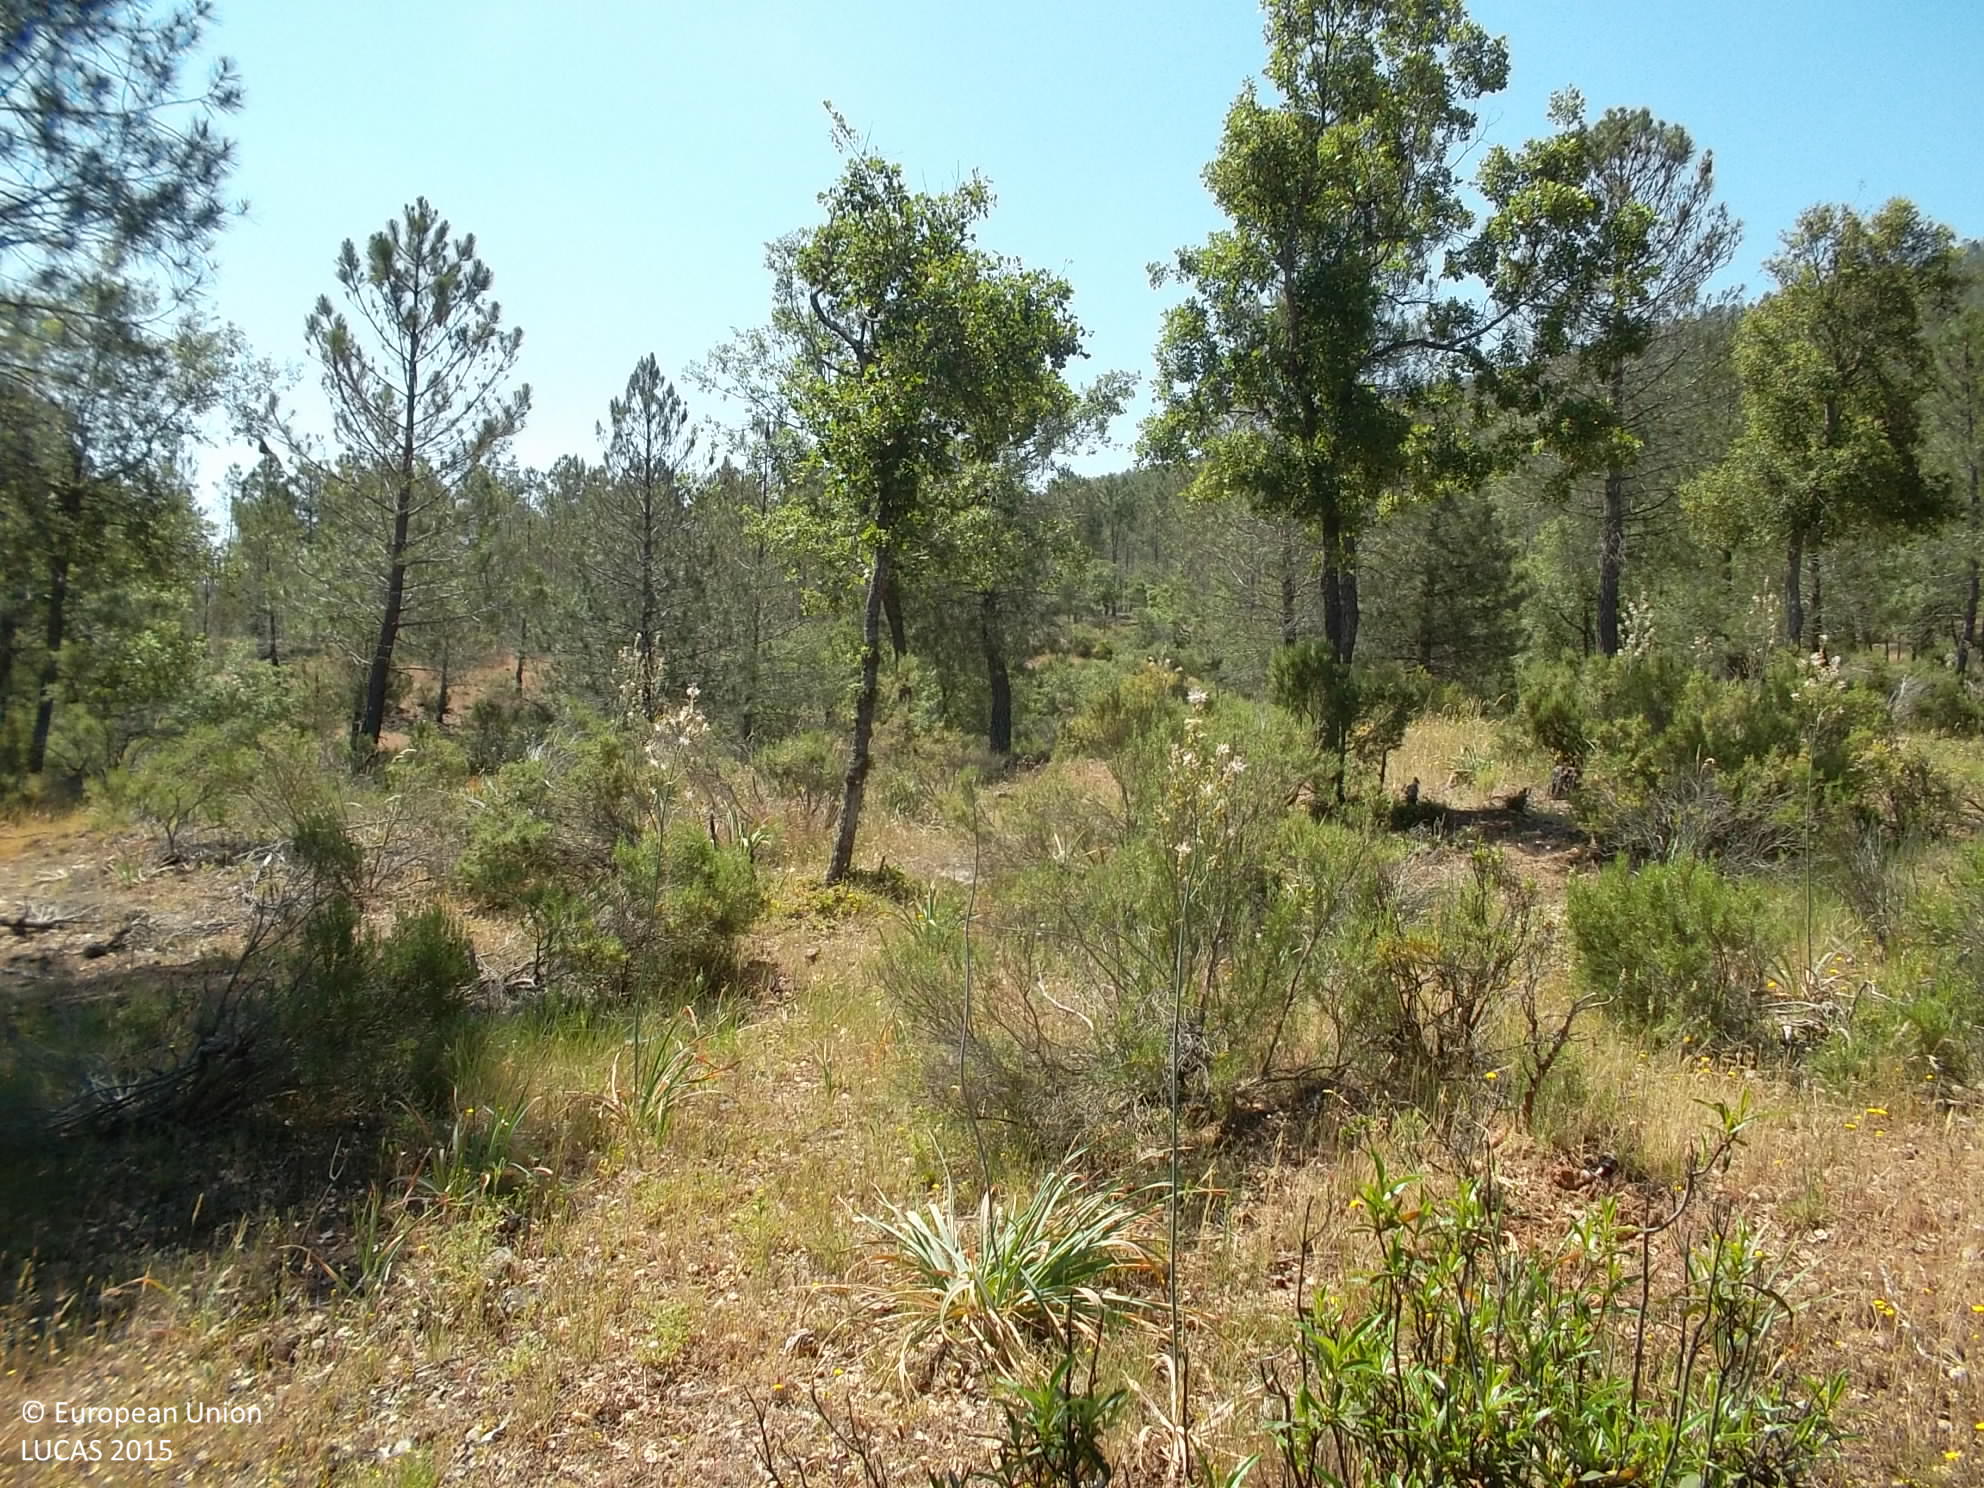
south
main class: Woodland
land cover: Pine dominated coniferous woodland
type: alpine coniferous forest
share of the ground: > 75 %
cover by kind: coniferous forest trees 40 %, herbaceous plants 40 %, shrubs 20 %
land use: Forestry
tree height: > 5 m
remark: Clear cut
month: May
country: ES
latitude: 38.5320
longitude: -4.4399
